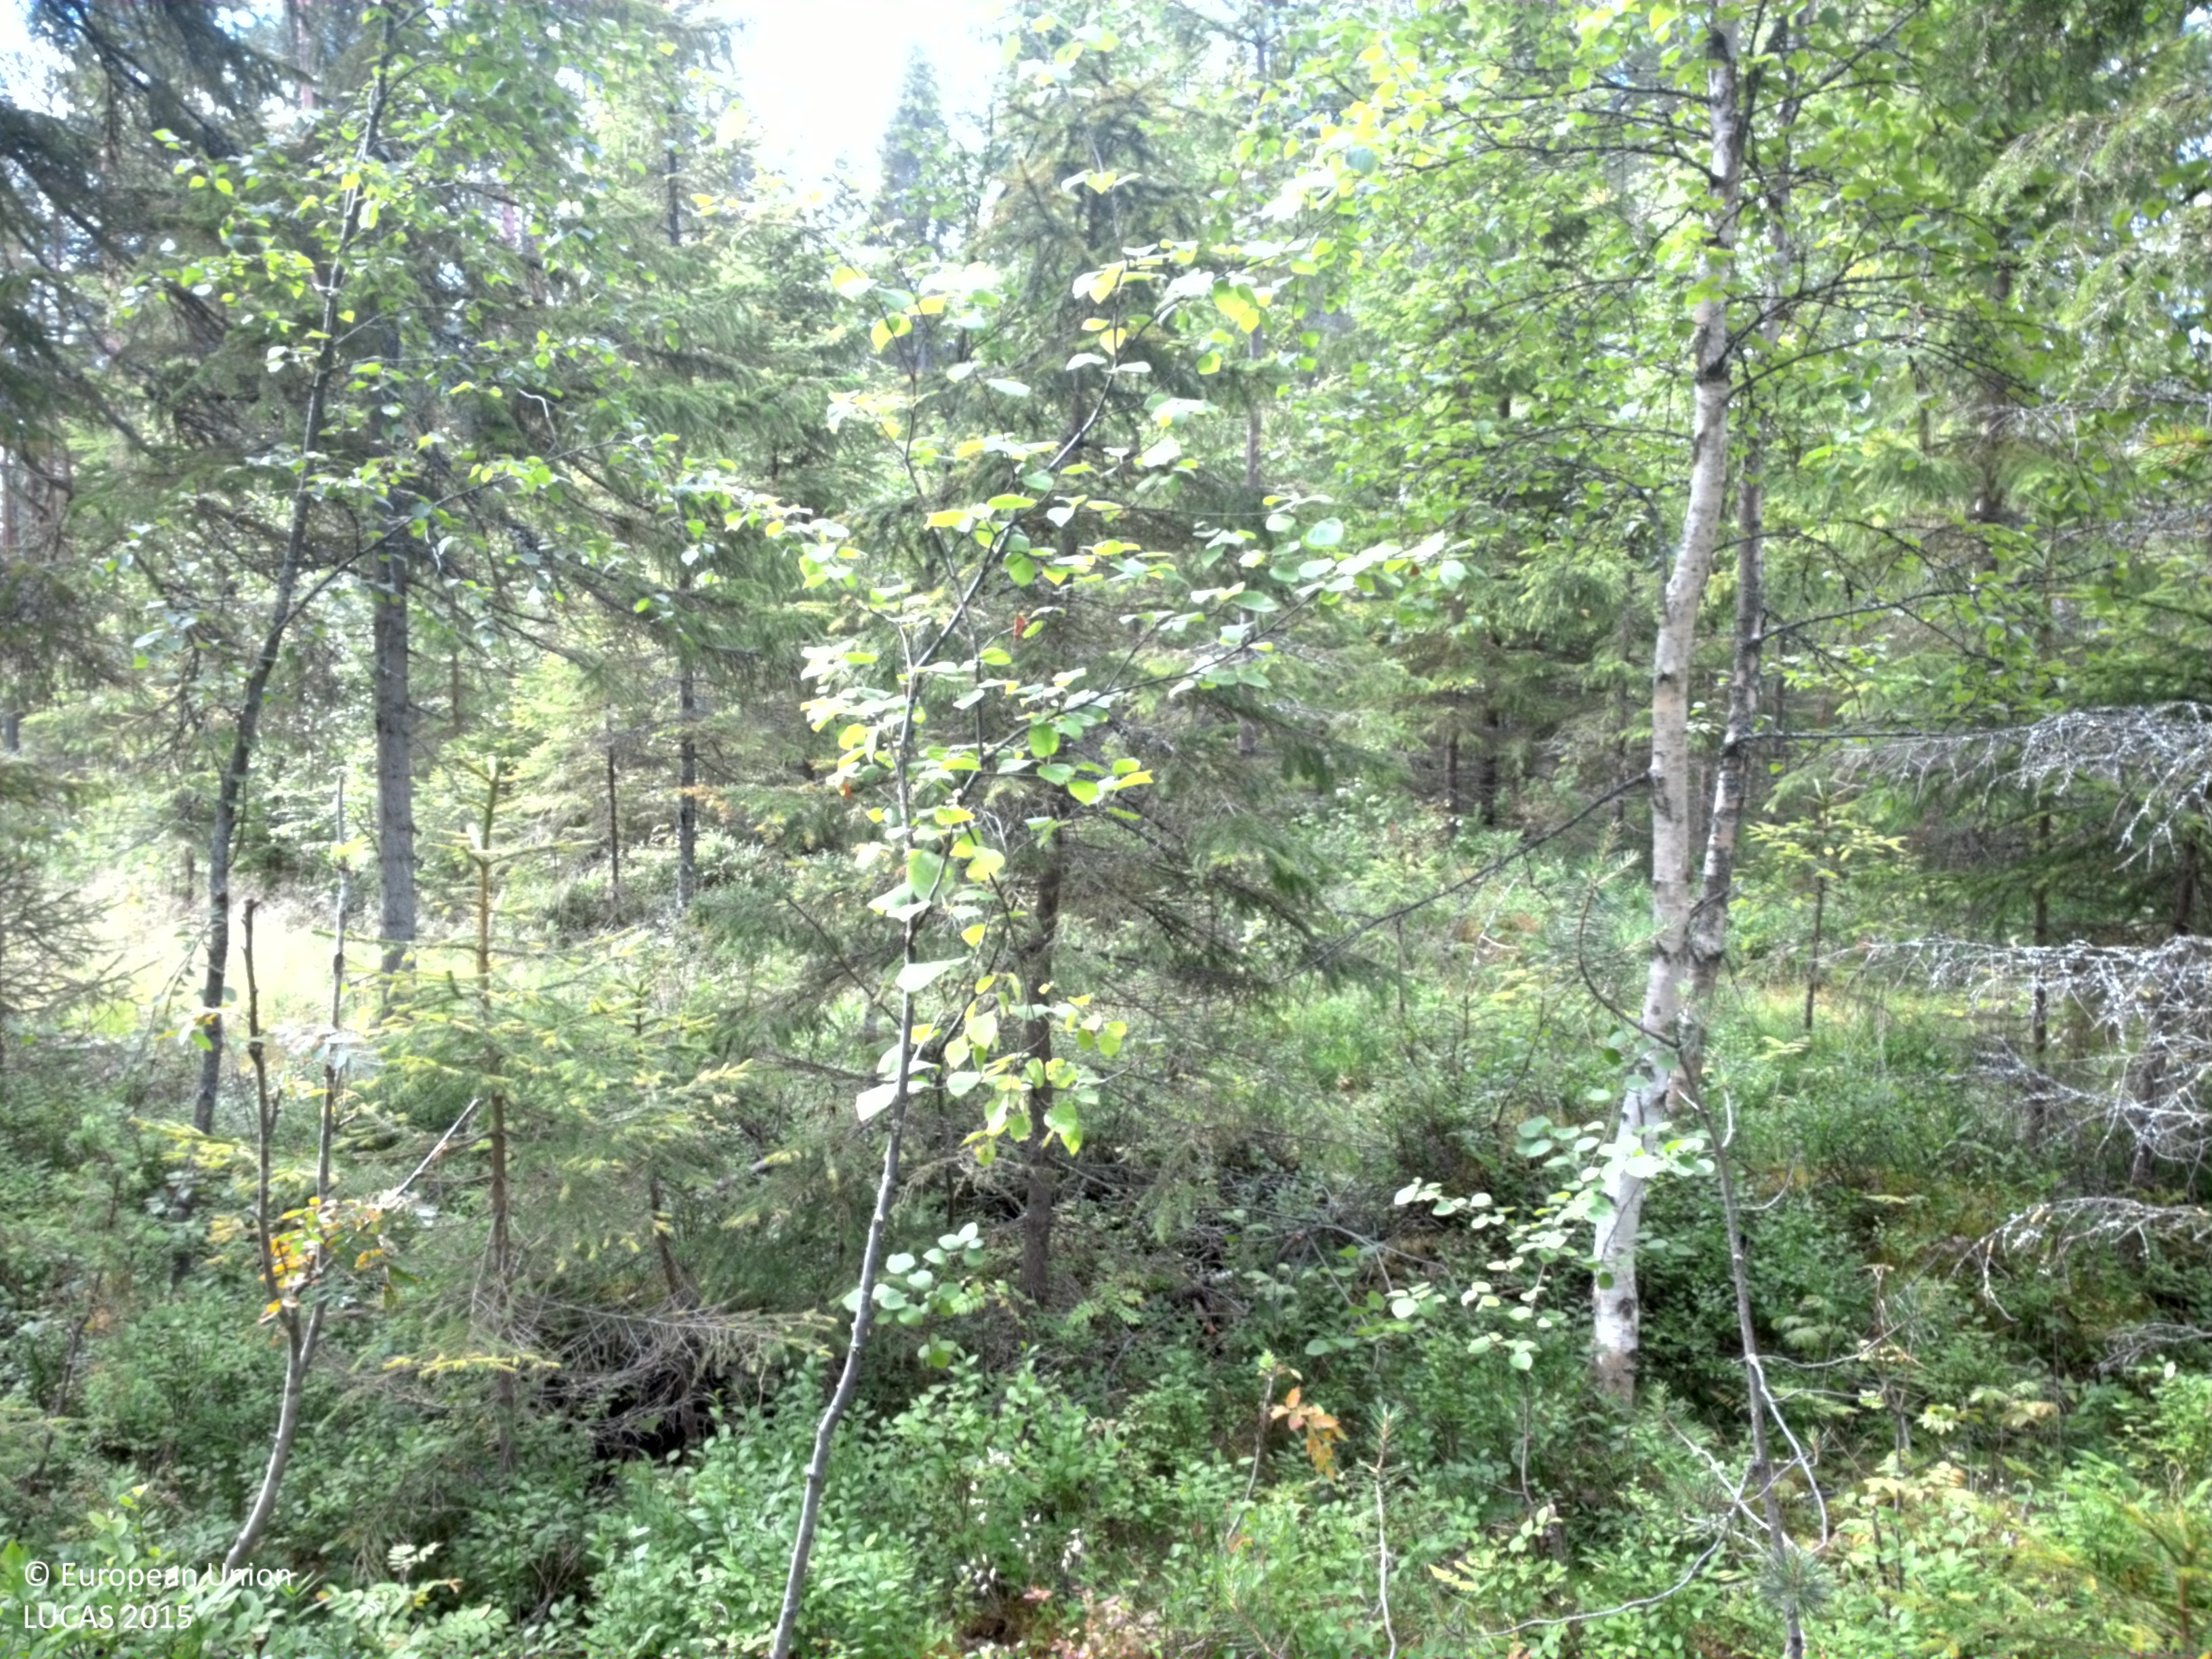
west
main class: Woodland
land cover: Other mixed woodland
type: boreal forest
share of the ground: 50 - 75 %
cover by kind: coniferous forest trees 45 %, shrubs 40 %, broadleaved forest trees 15 %
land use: Forestry
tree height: > 5 m
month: August
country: SE
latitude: 64.6263
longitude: 20.8754
